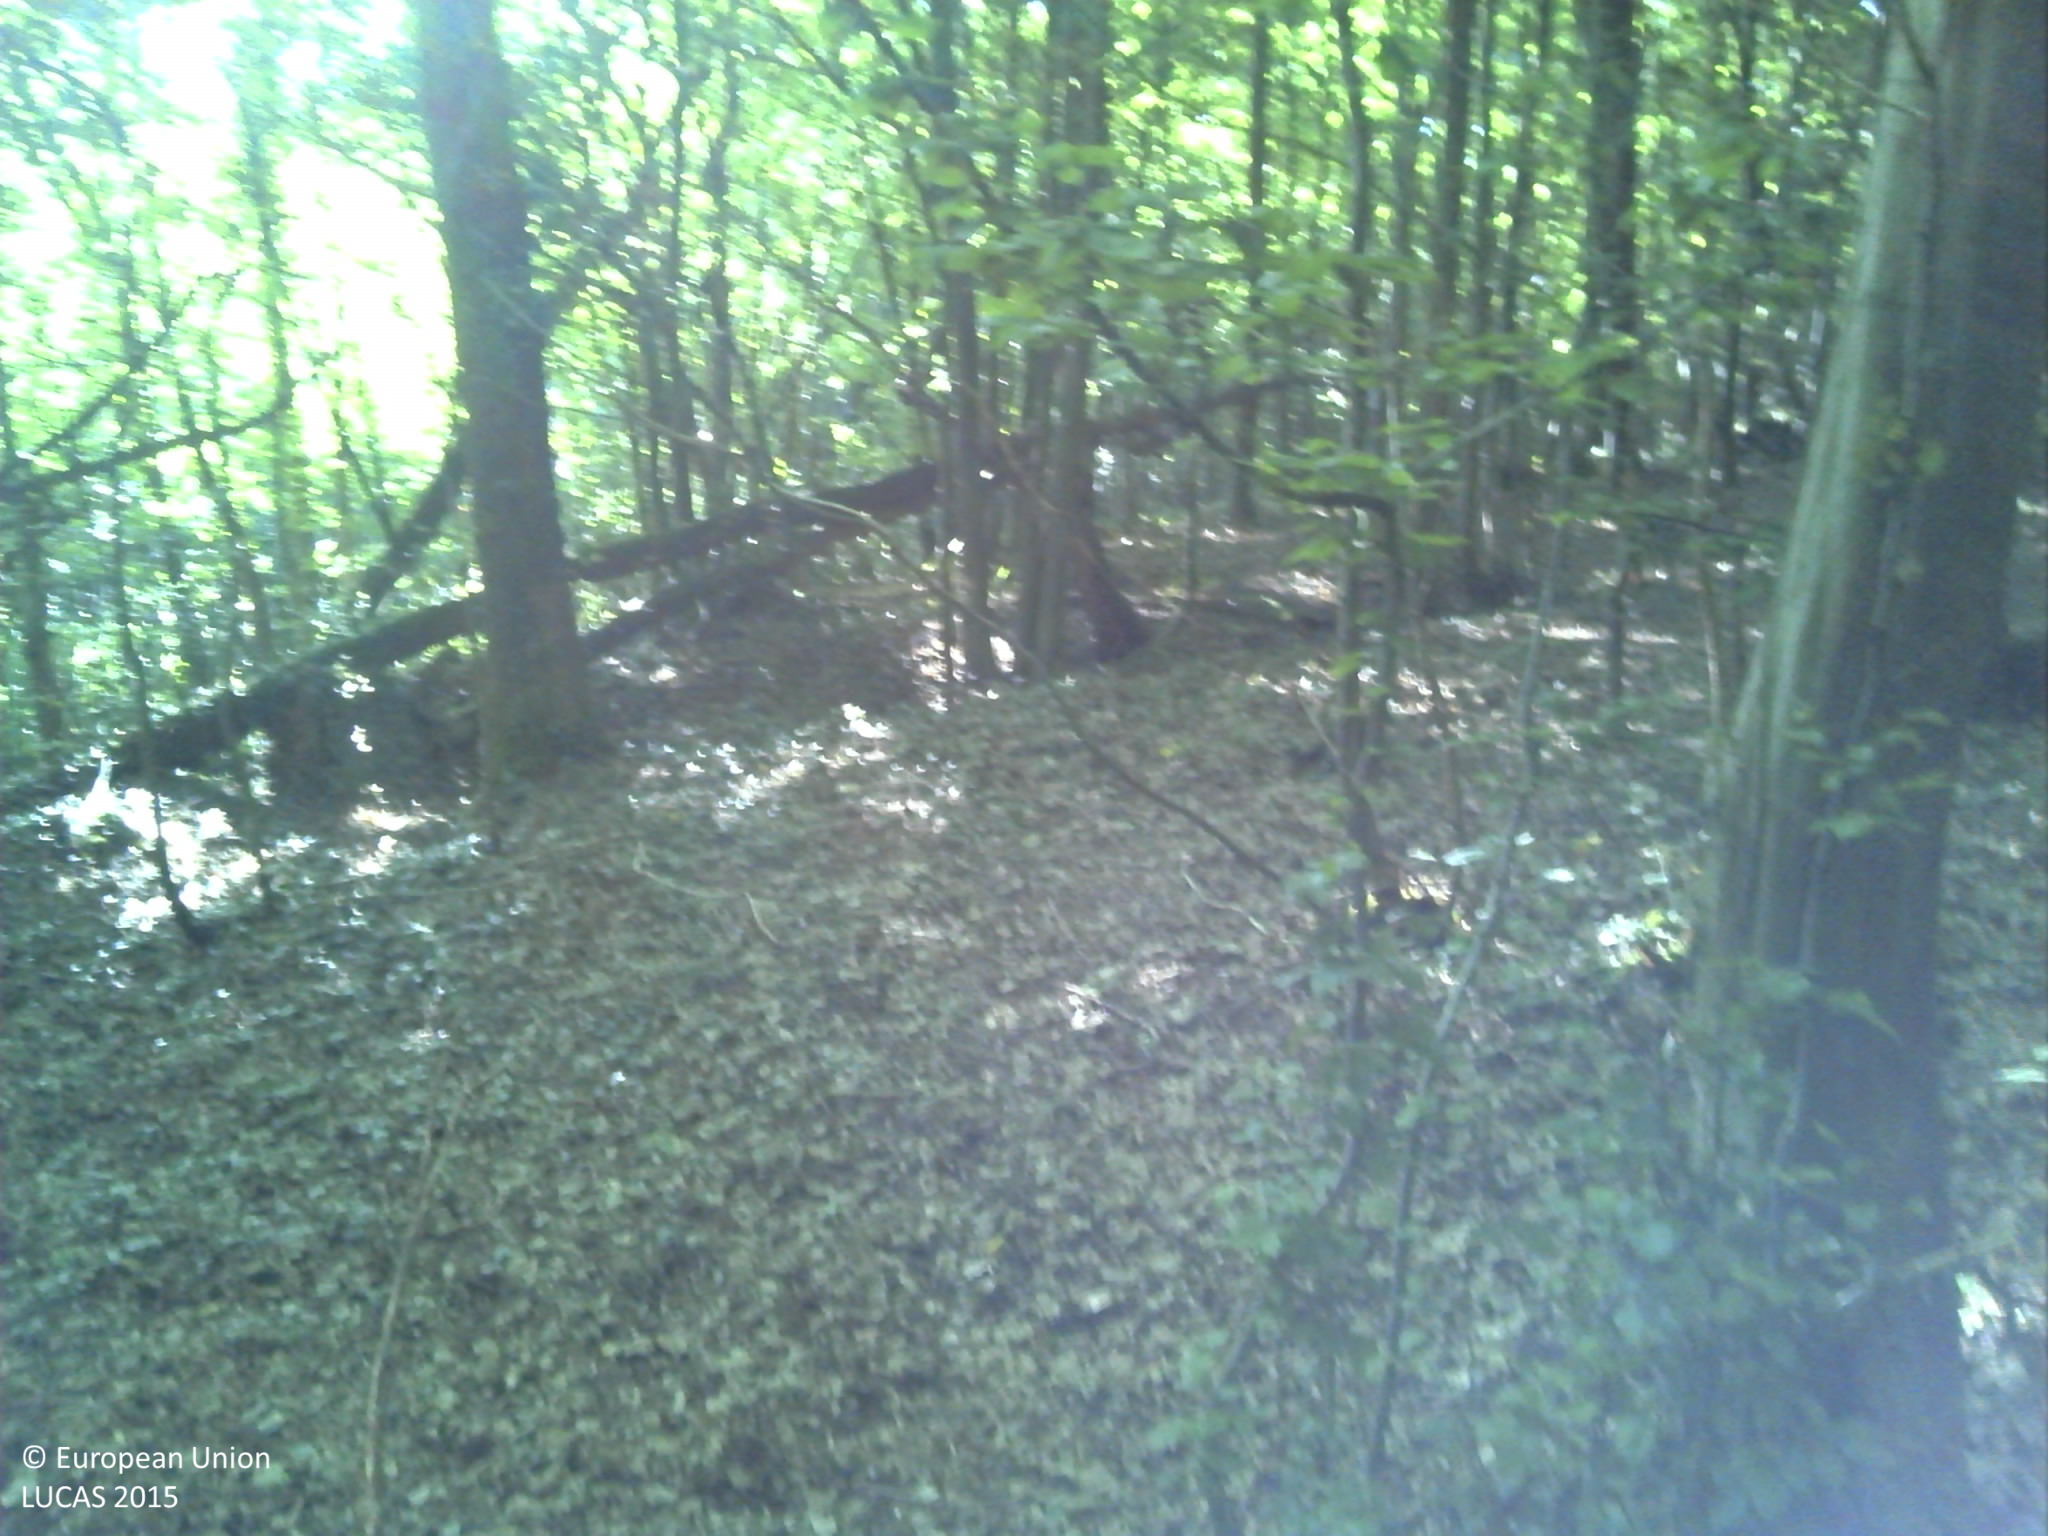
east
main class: Woodland
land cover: Broadleaved woodland
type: mesophytic deciduous forest
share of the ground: > 75 %
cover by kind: broadleaved forest trees 100 %
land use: Forestry
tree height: > 5 m
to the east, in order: Broadleaved woodland; Railways; Spontaneously vegetated surfaces; Railways; Broadleaved woodland; Tracks; Grass margins; Fences; Artificial constructions in urban areas
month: June
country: FR
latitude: 49.2692
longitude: 1.0314
